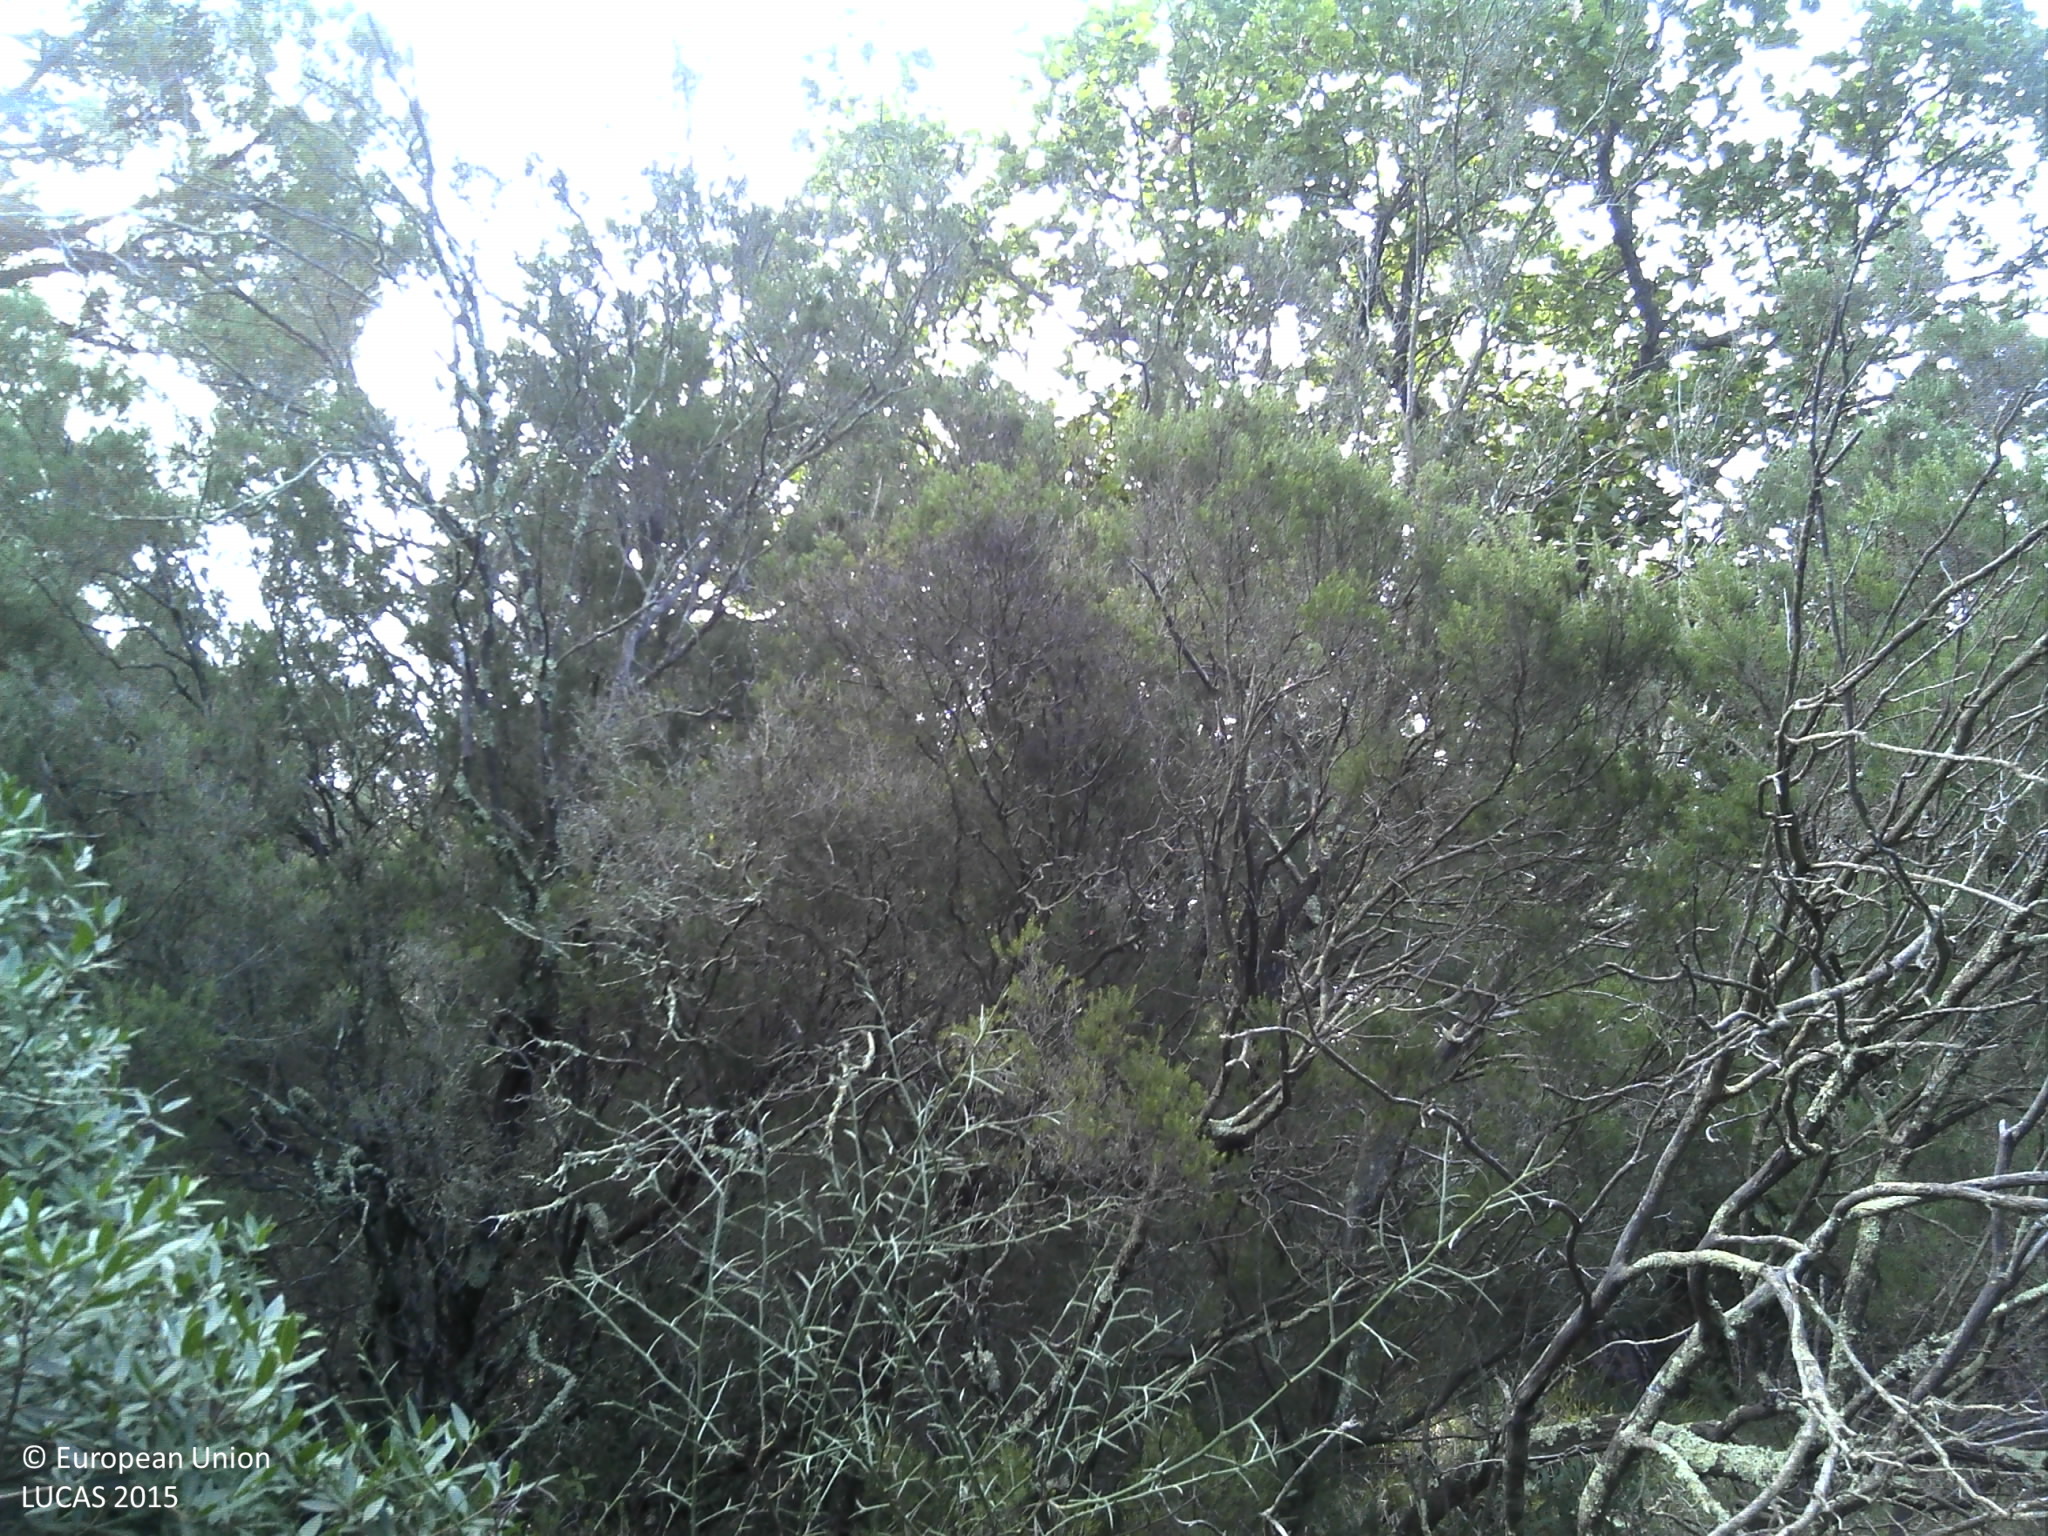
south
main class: Woodland
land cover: Pine dominated mixed woodland
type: broadleaved evergreen forest
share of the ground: > 75 %
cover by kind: broadleaved forest trees 50 %, coniferous forest trees 25 %, shrubs 25 %
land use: Semi-natural and natural areas not in use
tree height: > 5 m
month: October
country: FR
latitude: 43.1941
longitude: 6.6249
